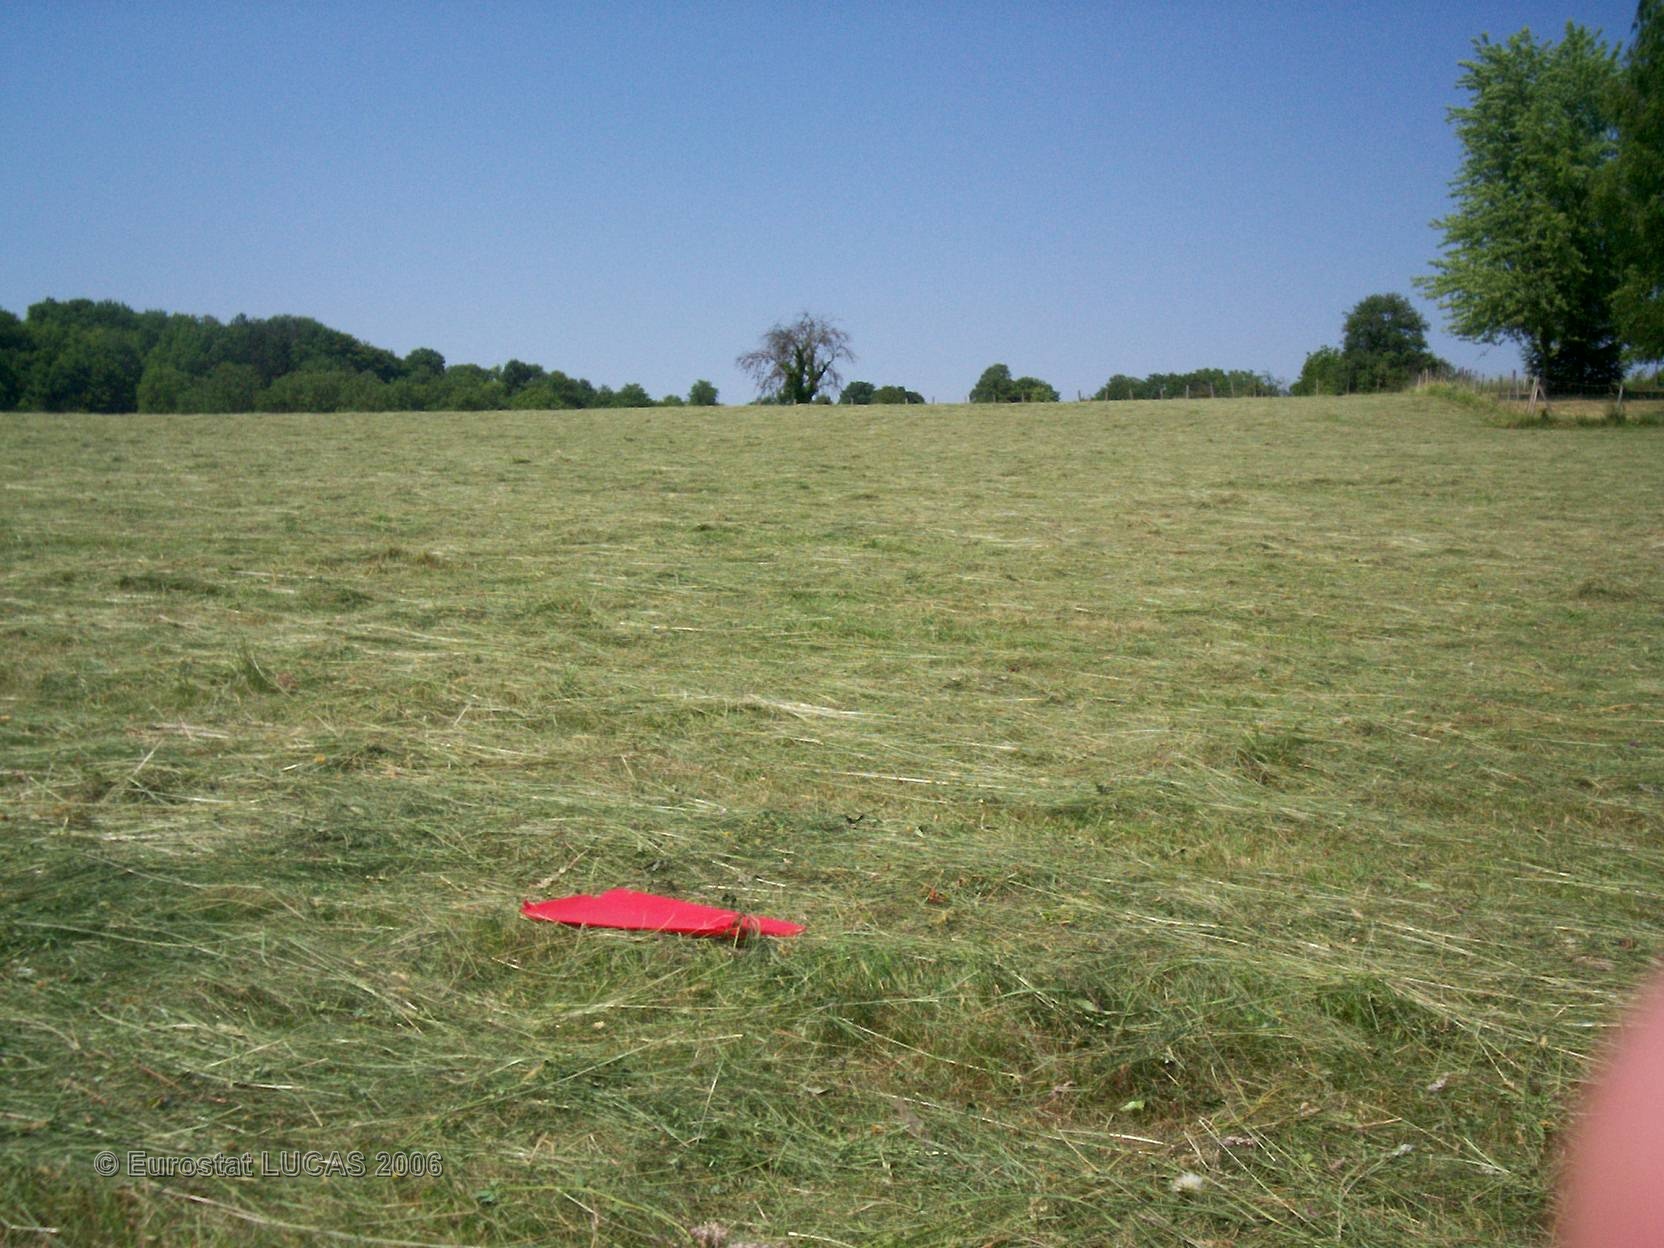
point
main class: Grassland
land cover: Grassland without tree/shrub cover
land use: Agriculture (excluding fallow land and kitchen gardens)
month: June
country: FR
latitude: 46.1073
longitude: 5.3846
